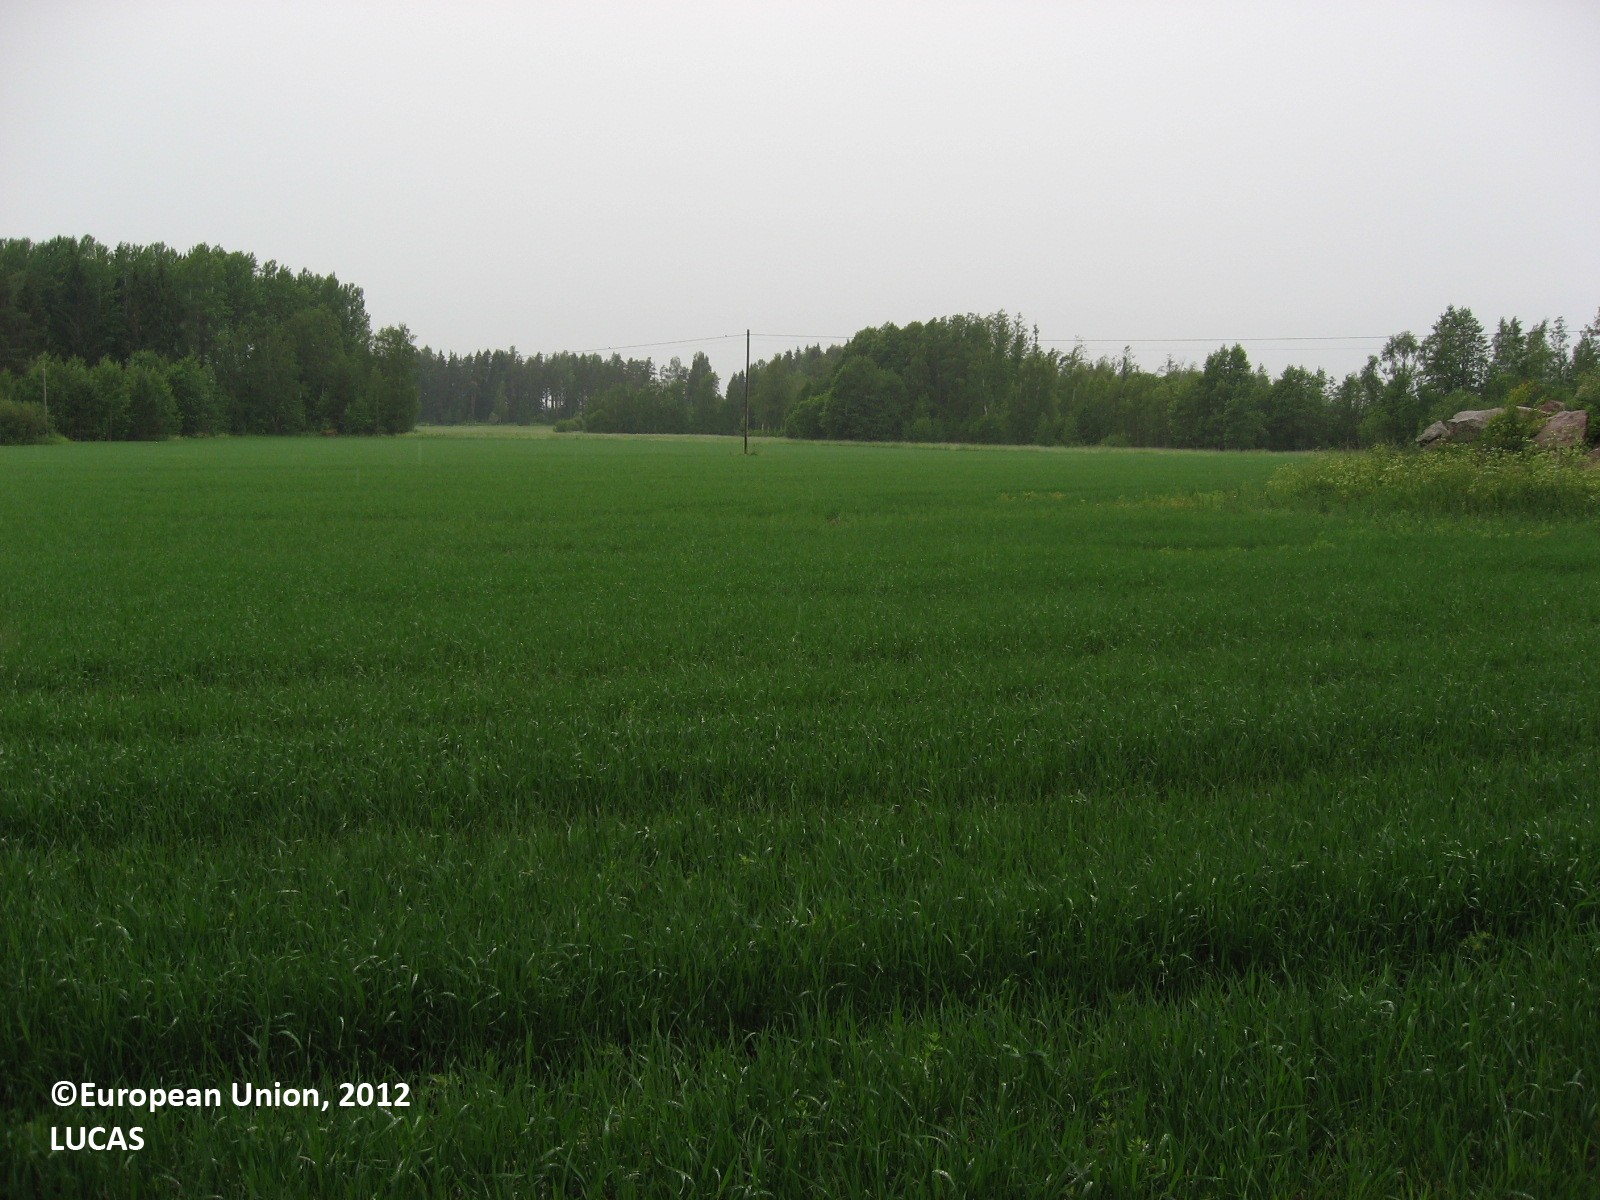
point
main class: Cropland
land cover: Common wheat
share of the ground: > 75 %
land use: Agriculture (excluding fallow land and kitchen gardens)
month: June
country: FI
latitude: 60.5337
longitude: 26.1282
